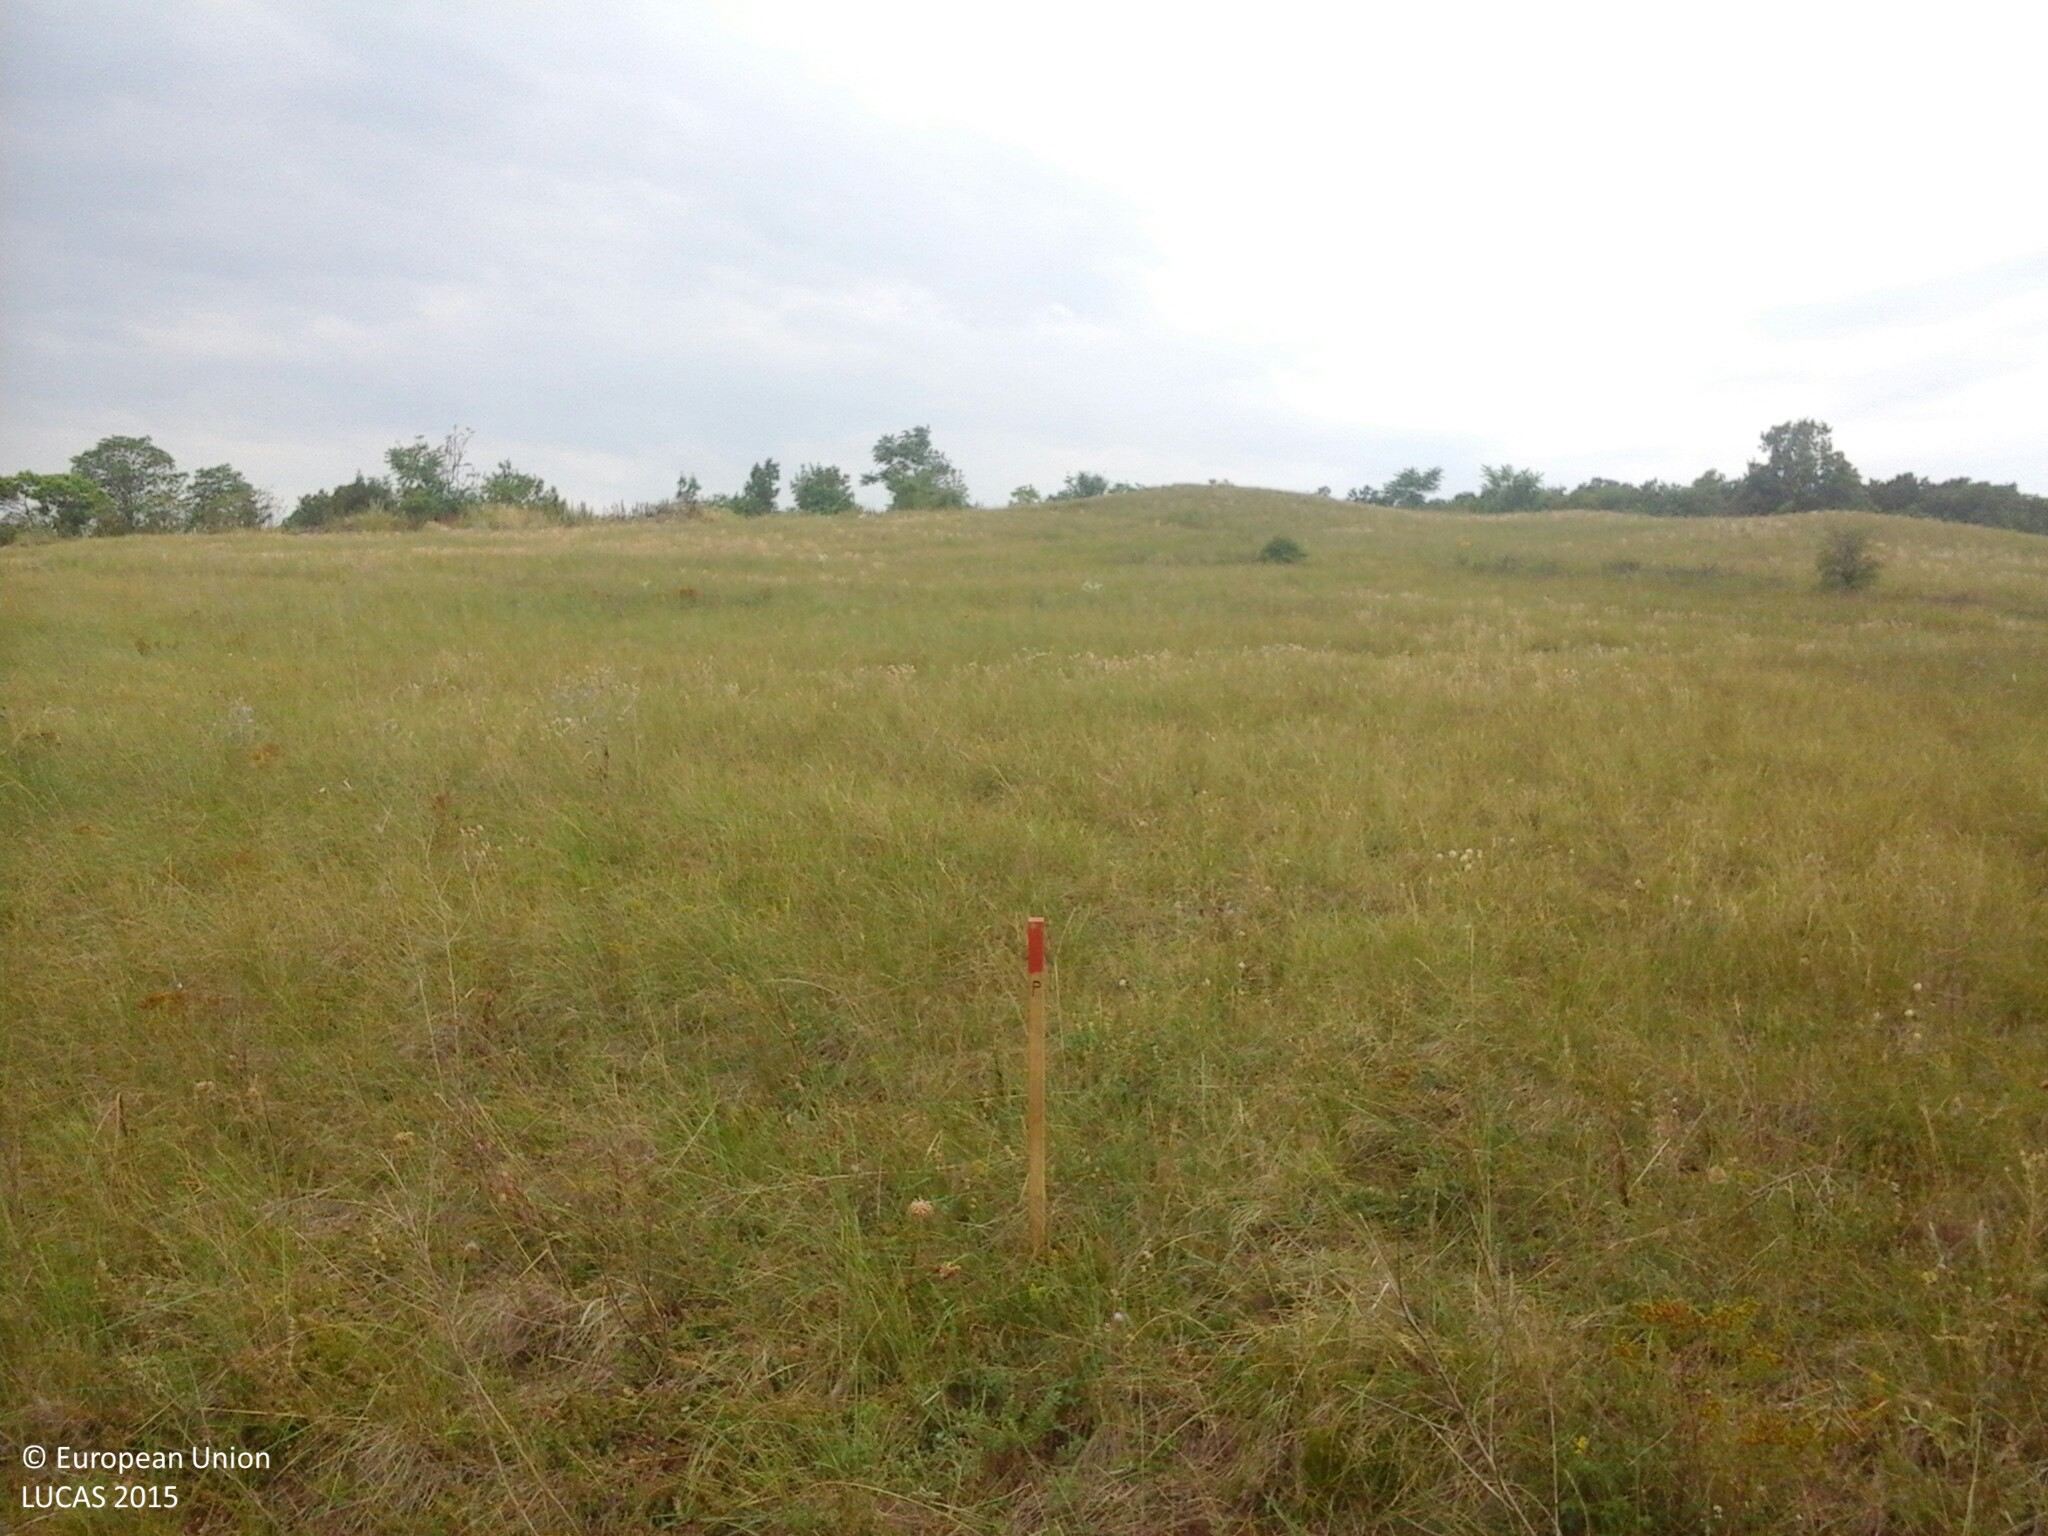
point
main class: Grassland
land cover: Grassland without tree/shrub cover
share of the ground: > 75 %
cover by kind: herbaceous plants 100 %
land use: Agriculture (excluding fallow land and kitchen gardens)
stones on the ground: 10 - 25 %
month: July
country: HU
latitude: 47.1498
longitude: 18.0679
